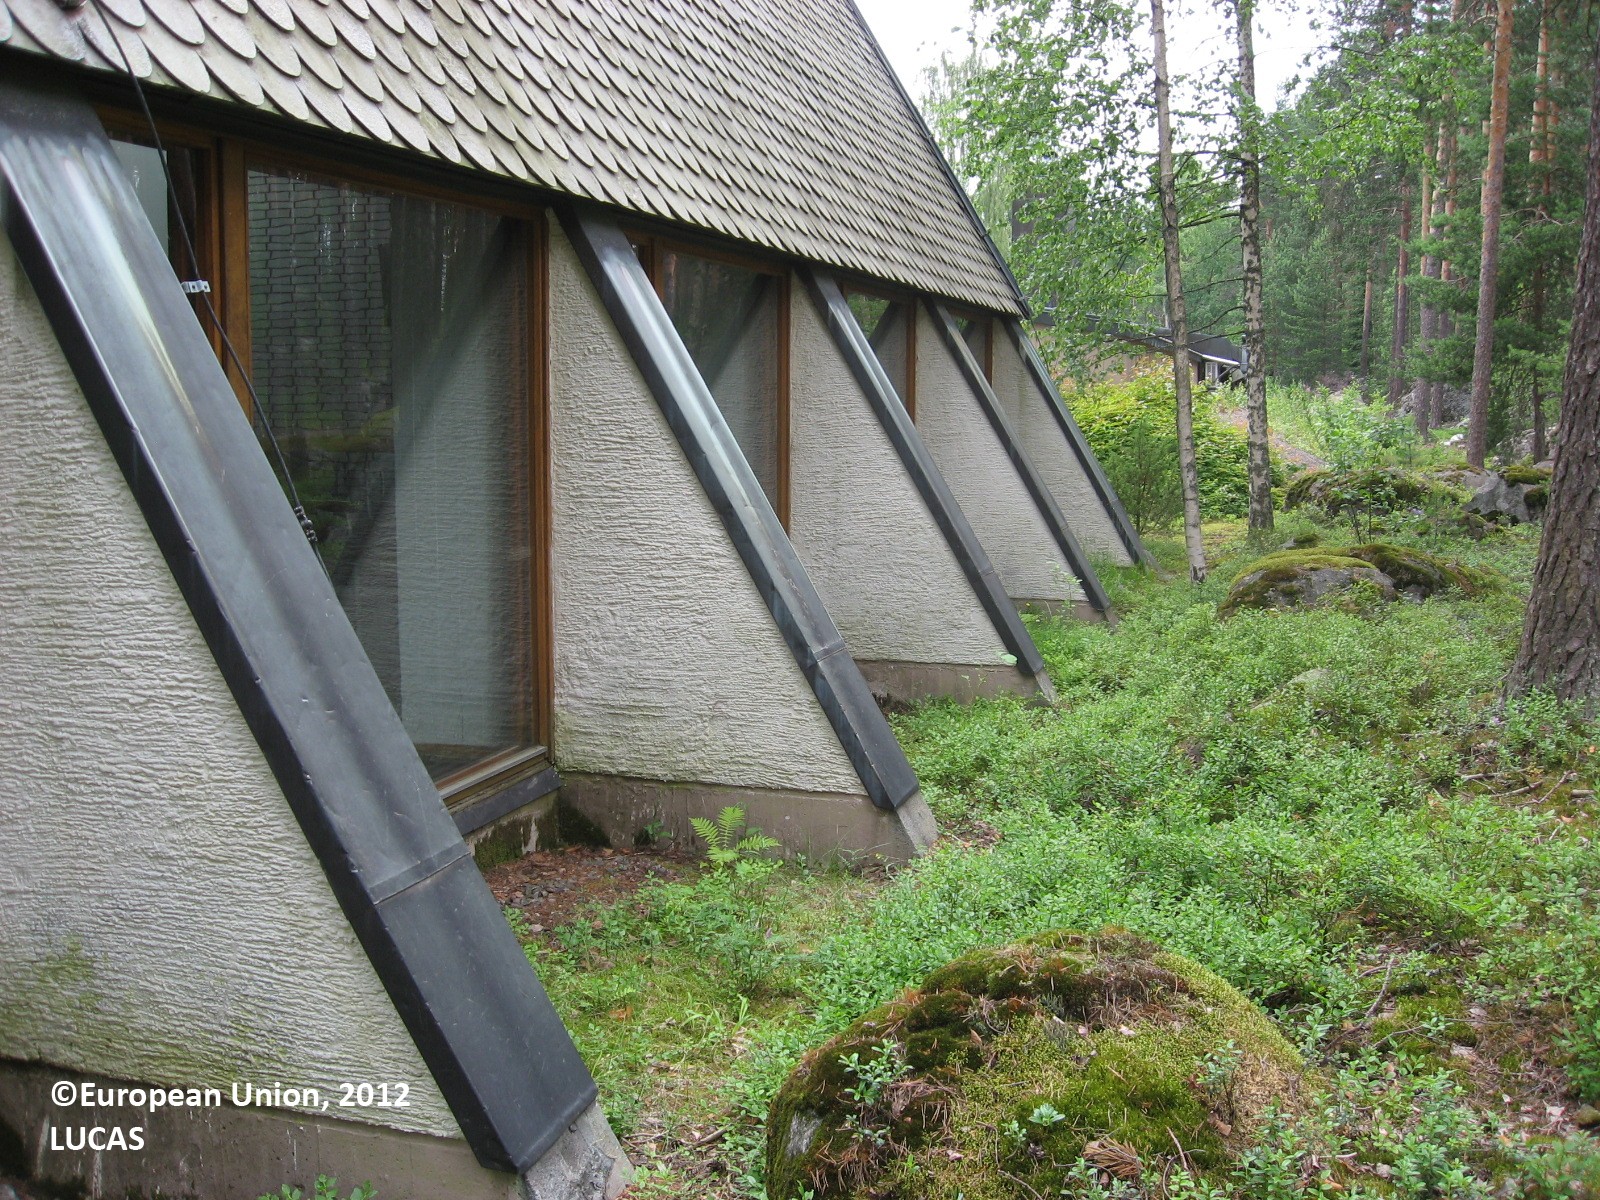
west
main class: Woodland
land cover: Pine dominated coniferous woodland
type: boreal forest
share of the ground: 50 - 75 %
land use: Community services
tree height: > 5 m
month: July
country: FI
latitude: 60.9650
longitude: 25.7392
